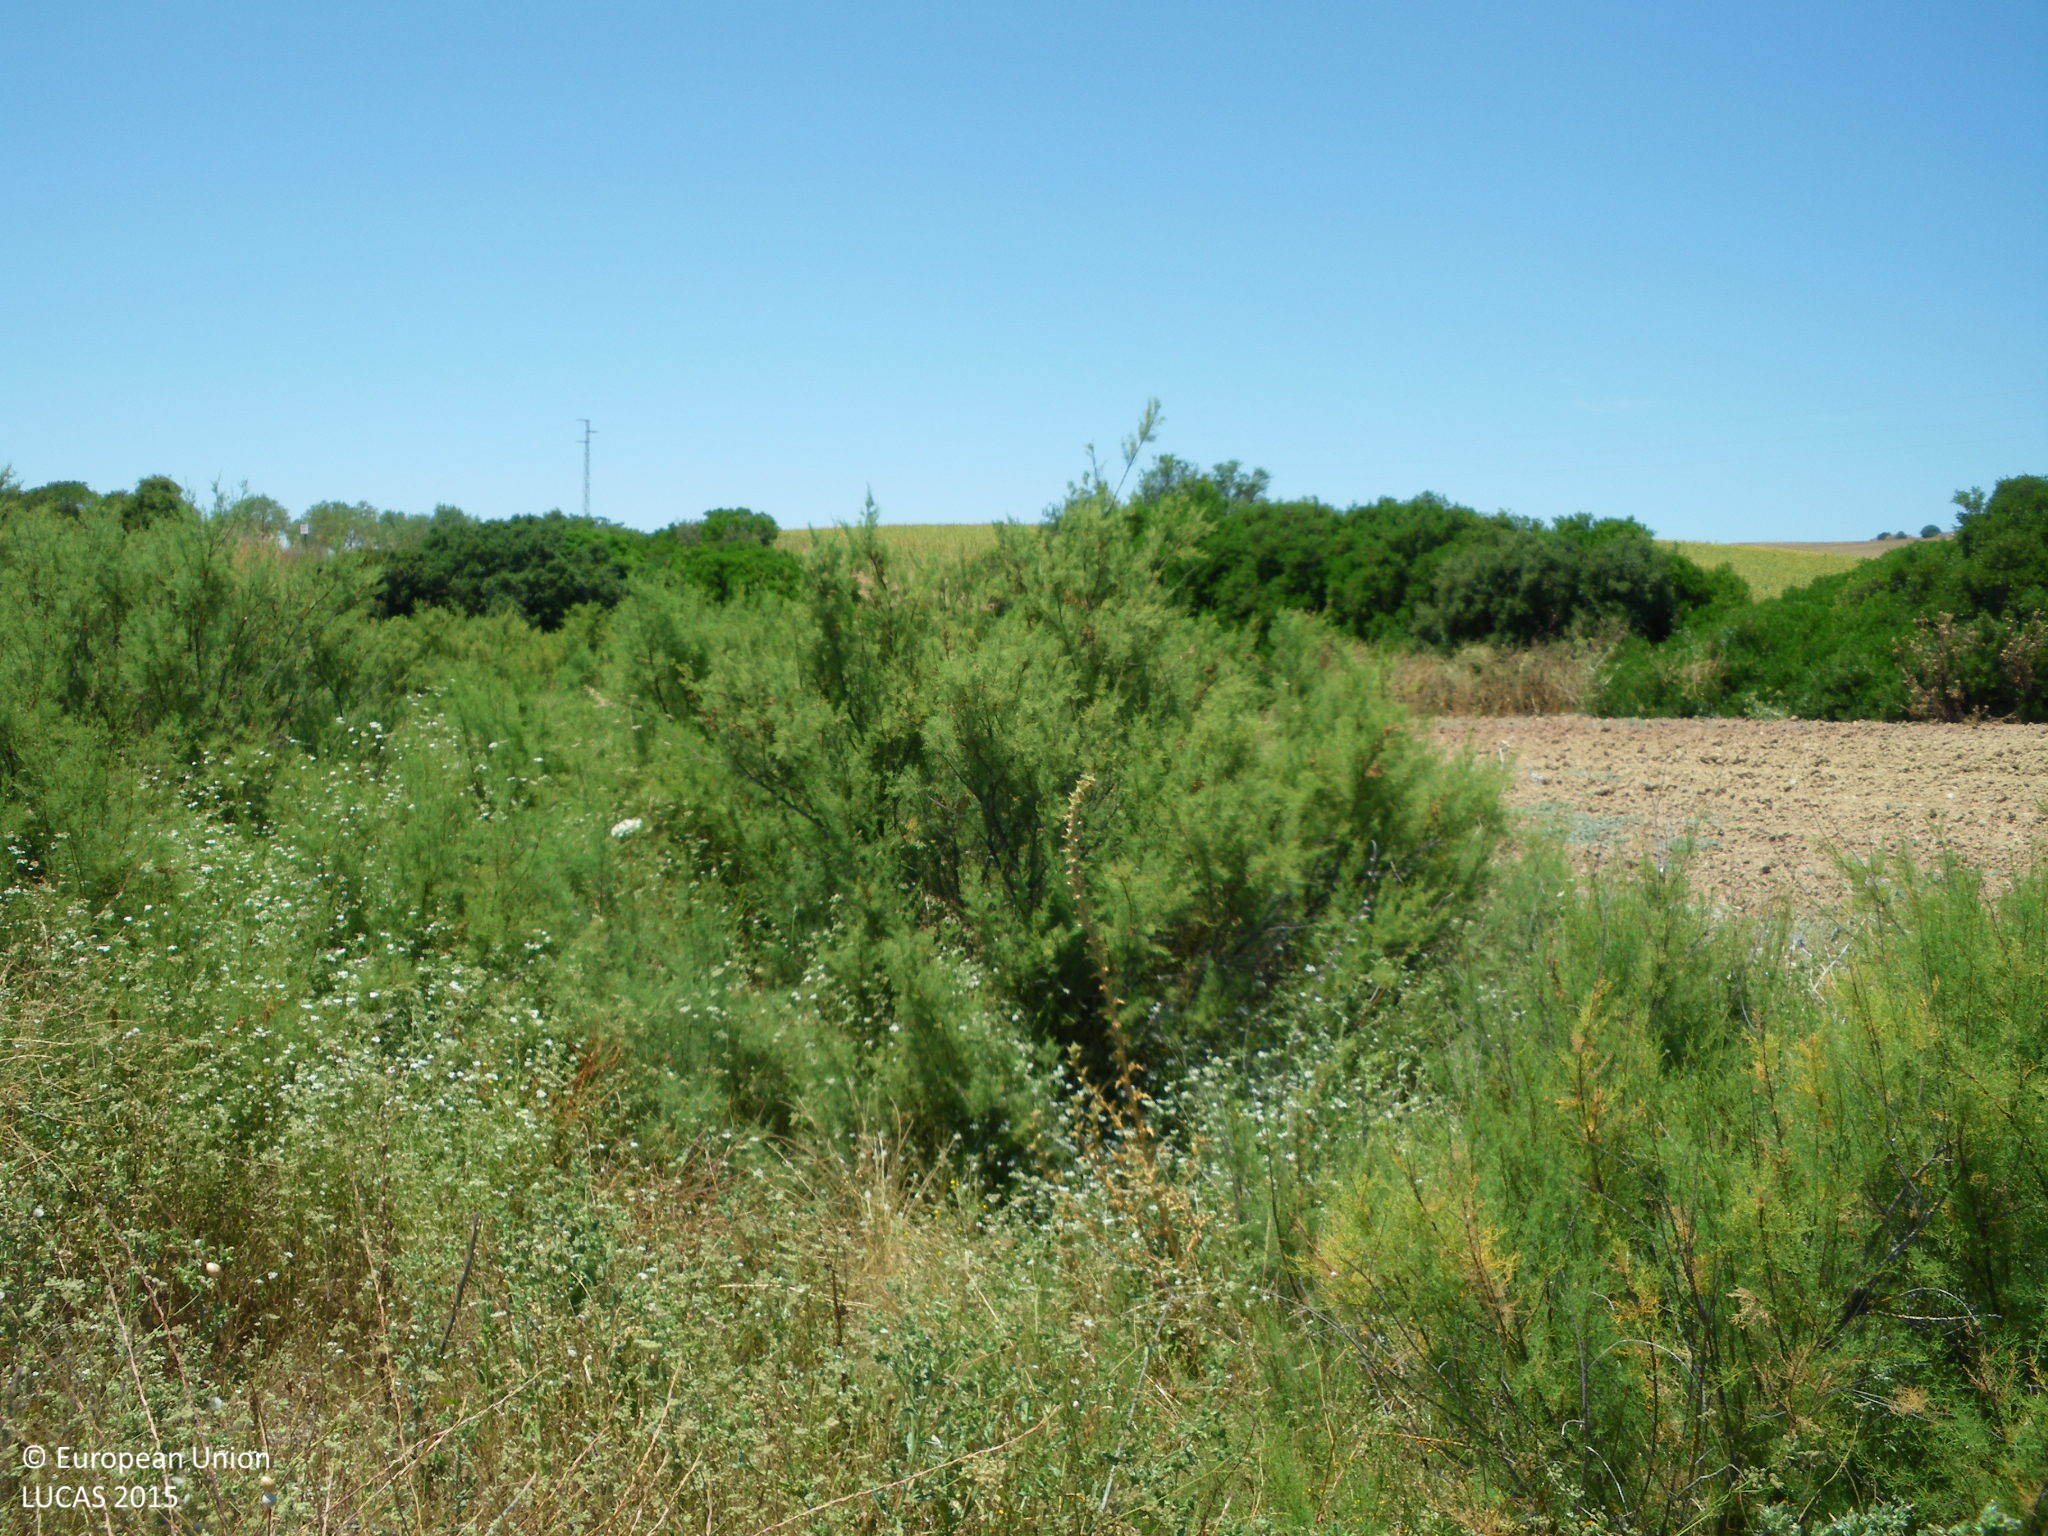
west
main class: Grassland
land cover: Grassland without tree/shrub cover
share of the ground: > 75 %
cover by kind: herbaceous plants 100 %
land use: Semi-natural and natural areas not in use
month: June
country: ES
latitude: 36.9006
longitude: -5.7784
